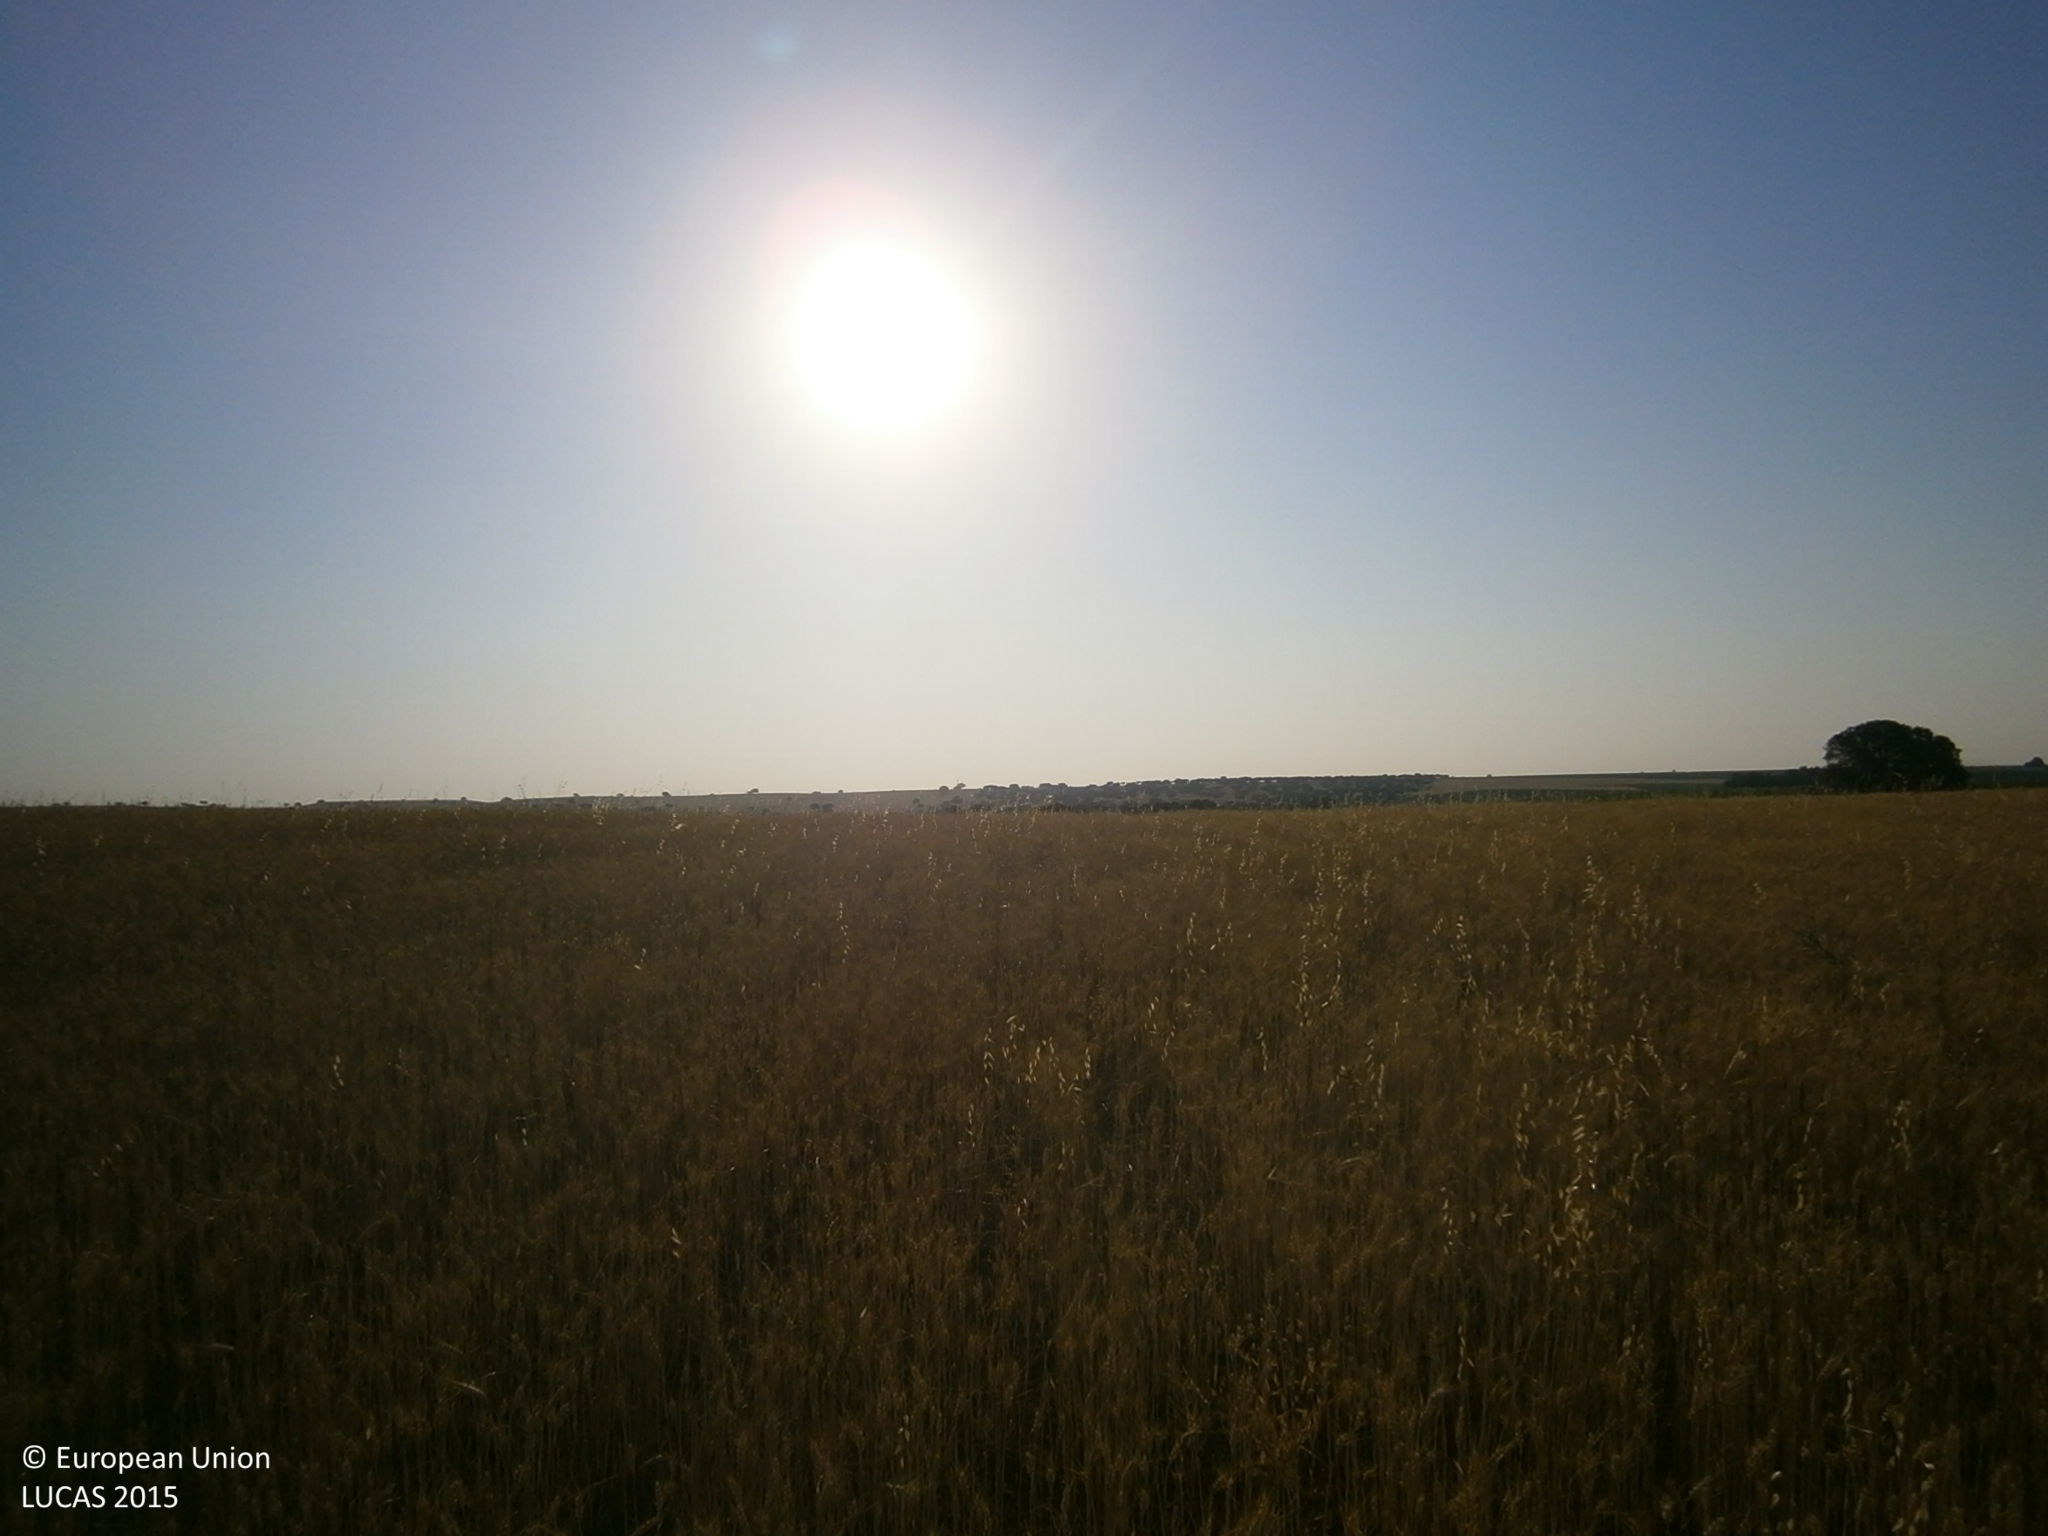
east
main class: Cropland
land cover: Durum wheat
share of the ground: > 75 %
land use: Agriculture (excluding fallow land and kitchen gardens)
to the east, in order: Durum wheat; Tracks; Vineyards
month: June
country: ES
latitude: 38.7369
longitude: -6.7788
